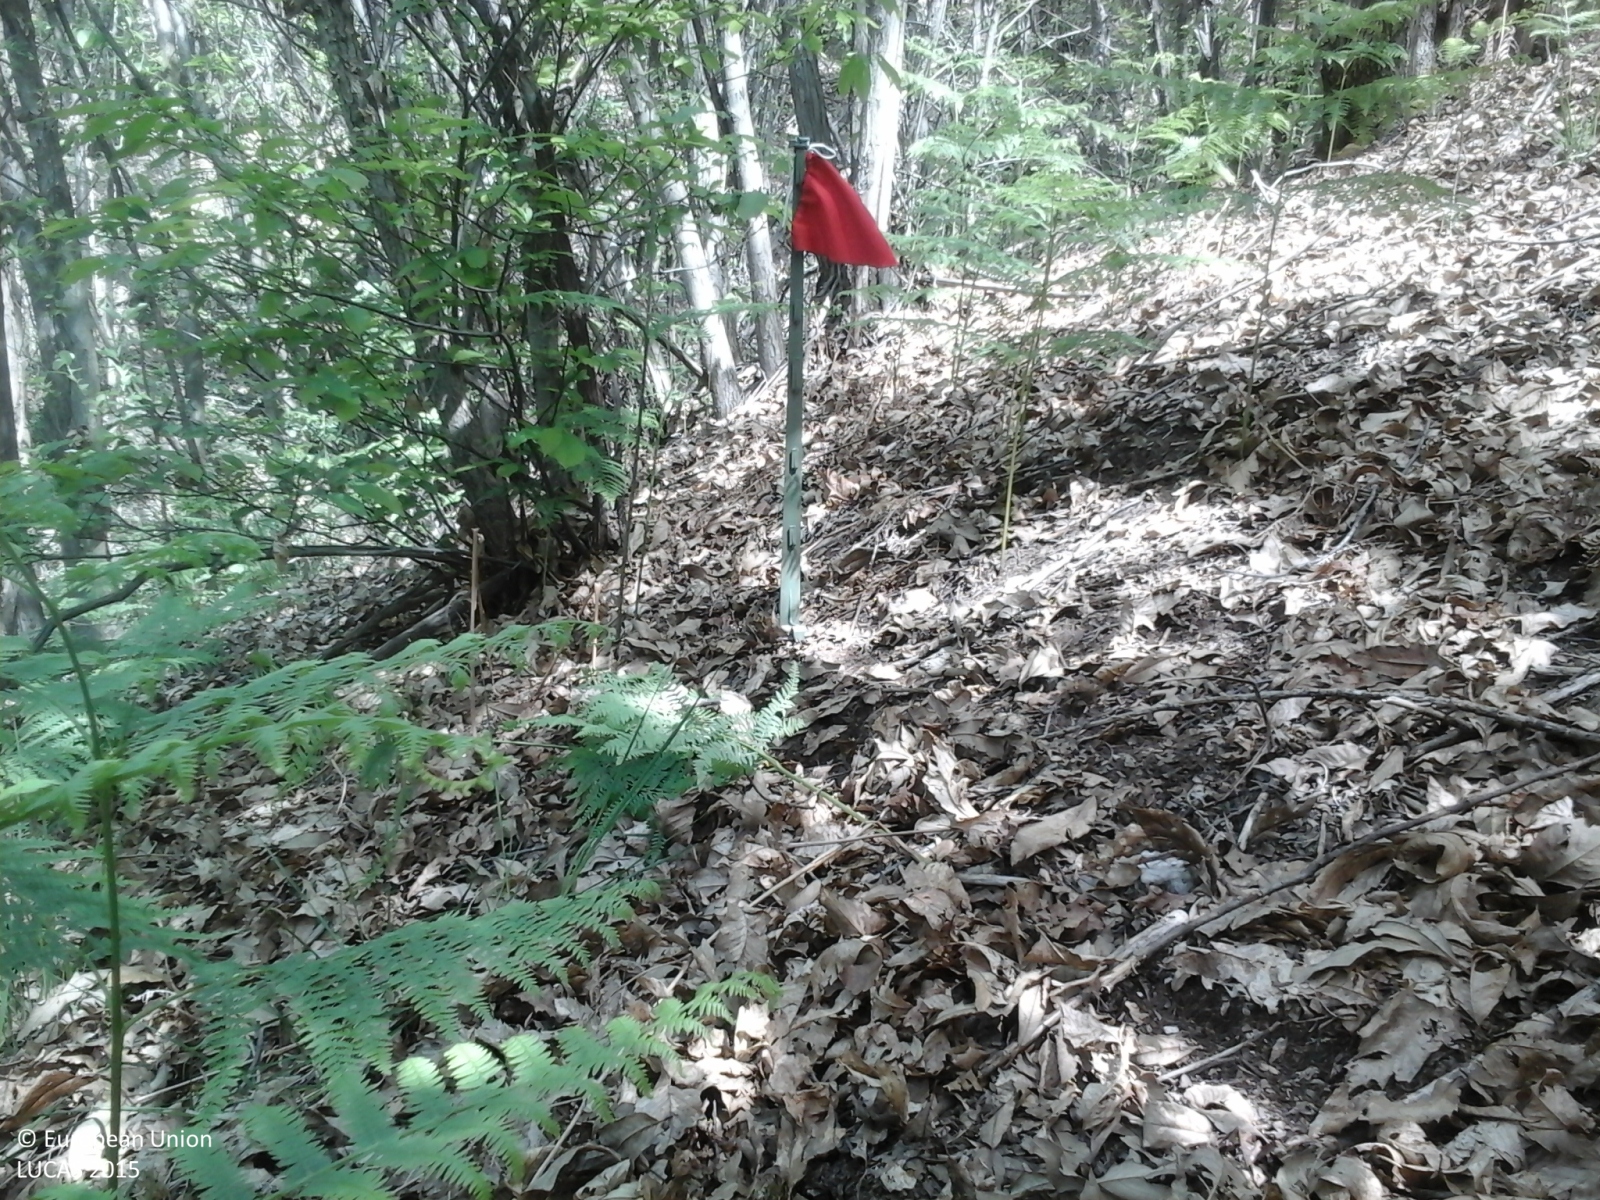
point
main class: Woodland
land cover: Broadleaved woodland
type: thermophilous deciduous forest
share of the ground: > 75 %
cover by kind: broadleaved forest trees 100 %
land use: Forestry
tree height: > 5 m
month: May
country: IT
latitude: 45.7442
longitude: 8.3701
